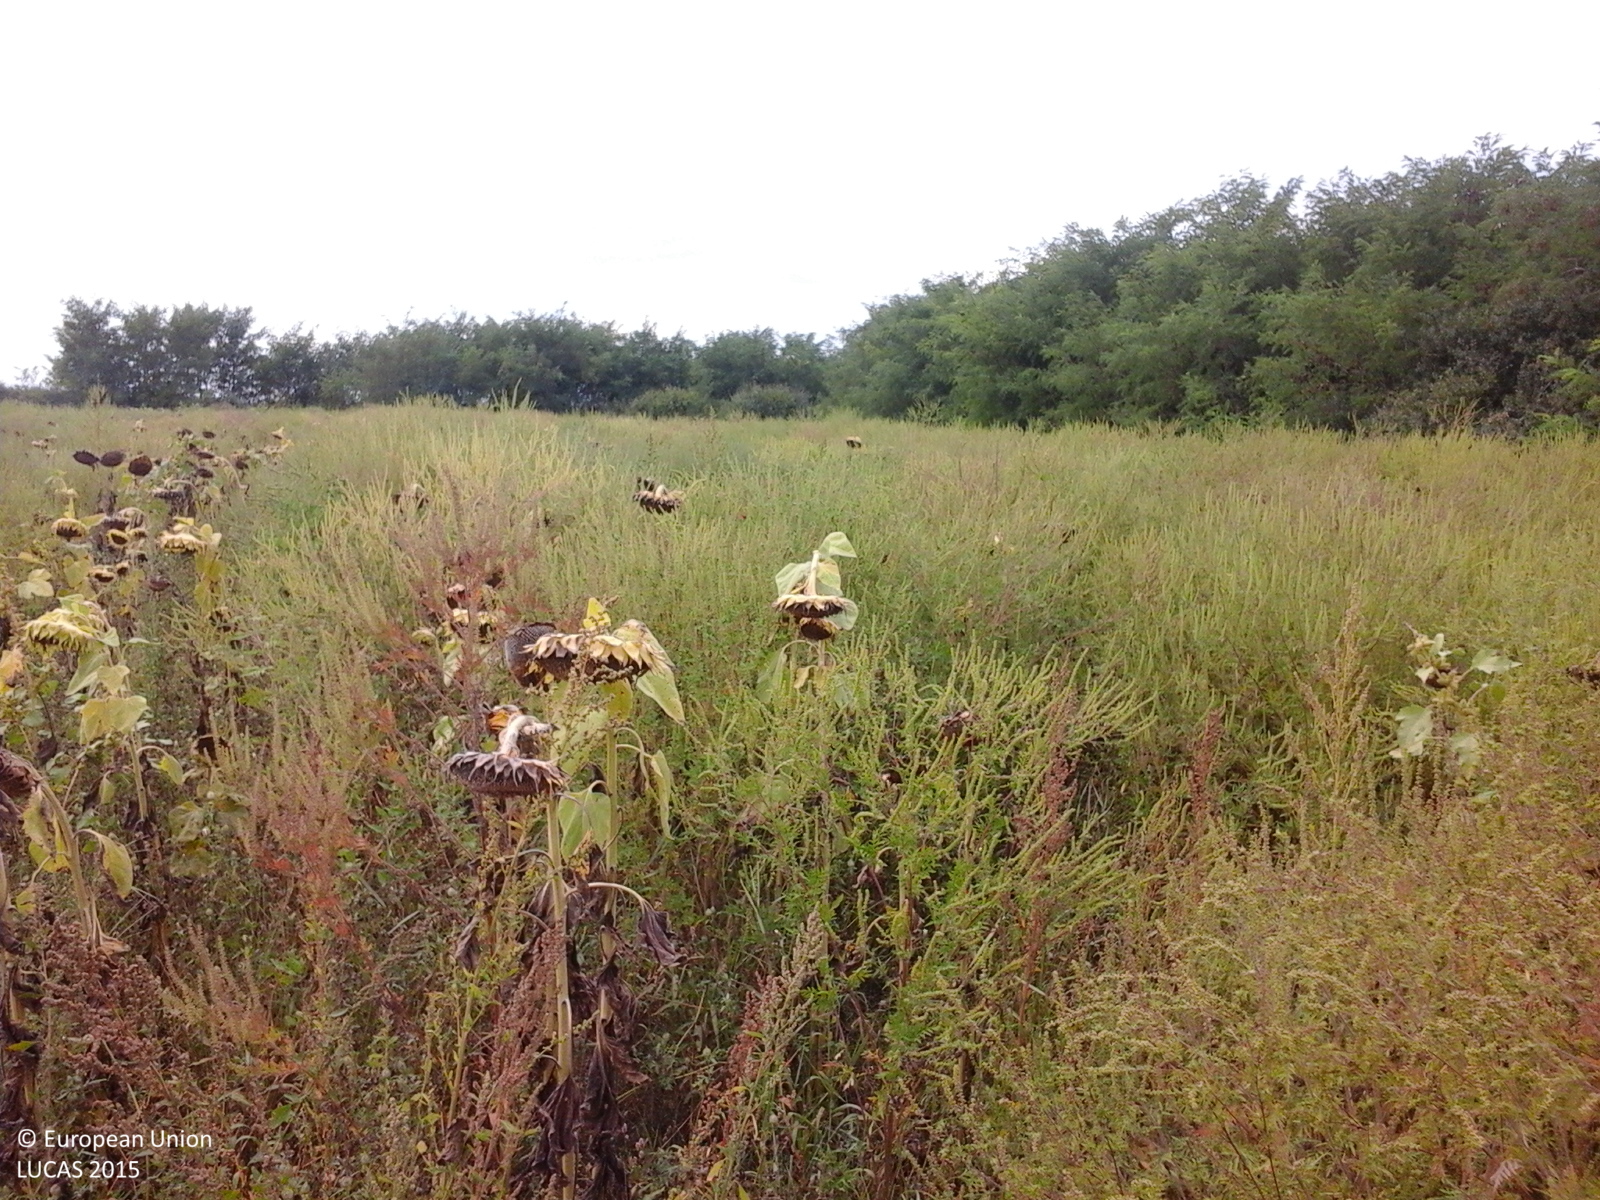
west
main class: Cropland
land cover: Sunflower
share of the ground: 50 - 75 %
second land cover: Spontaneously vegetated surfaces
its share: 25 - 50 %
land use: Agriculture (excluding fallow land and kitchen gardens)
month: September
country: RO
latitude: 47.5145
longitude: 22.6073
